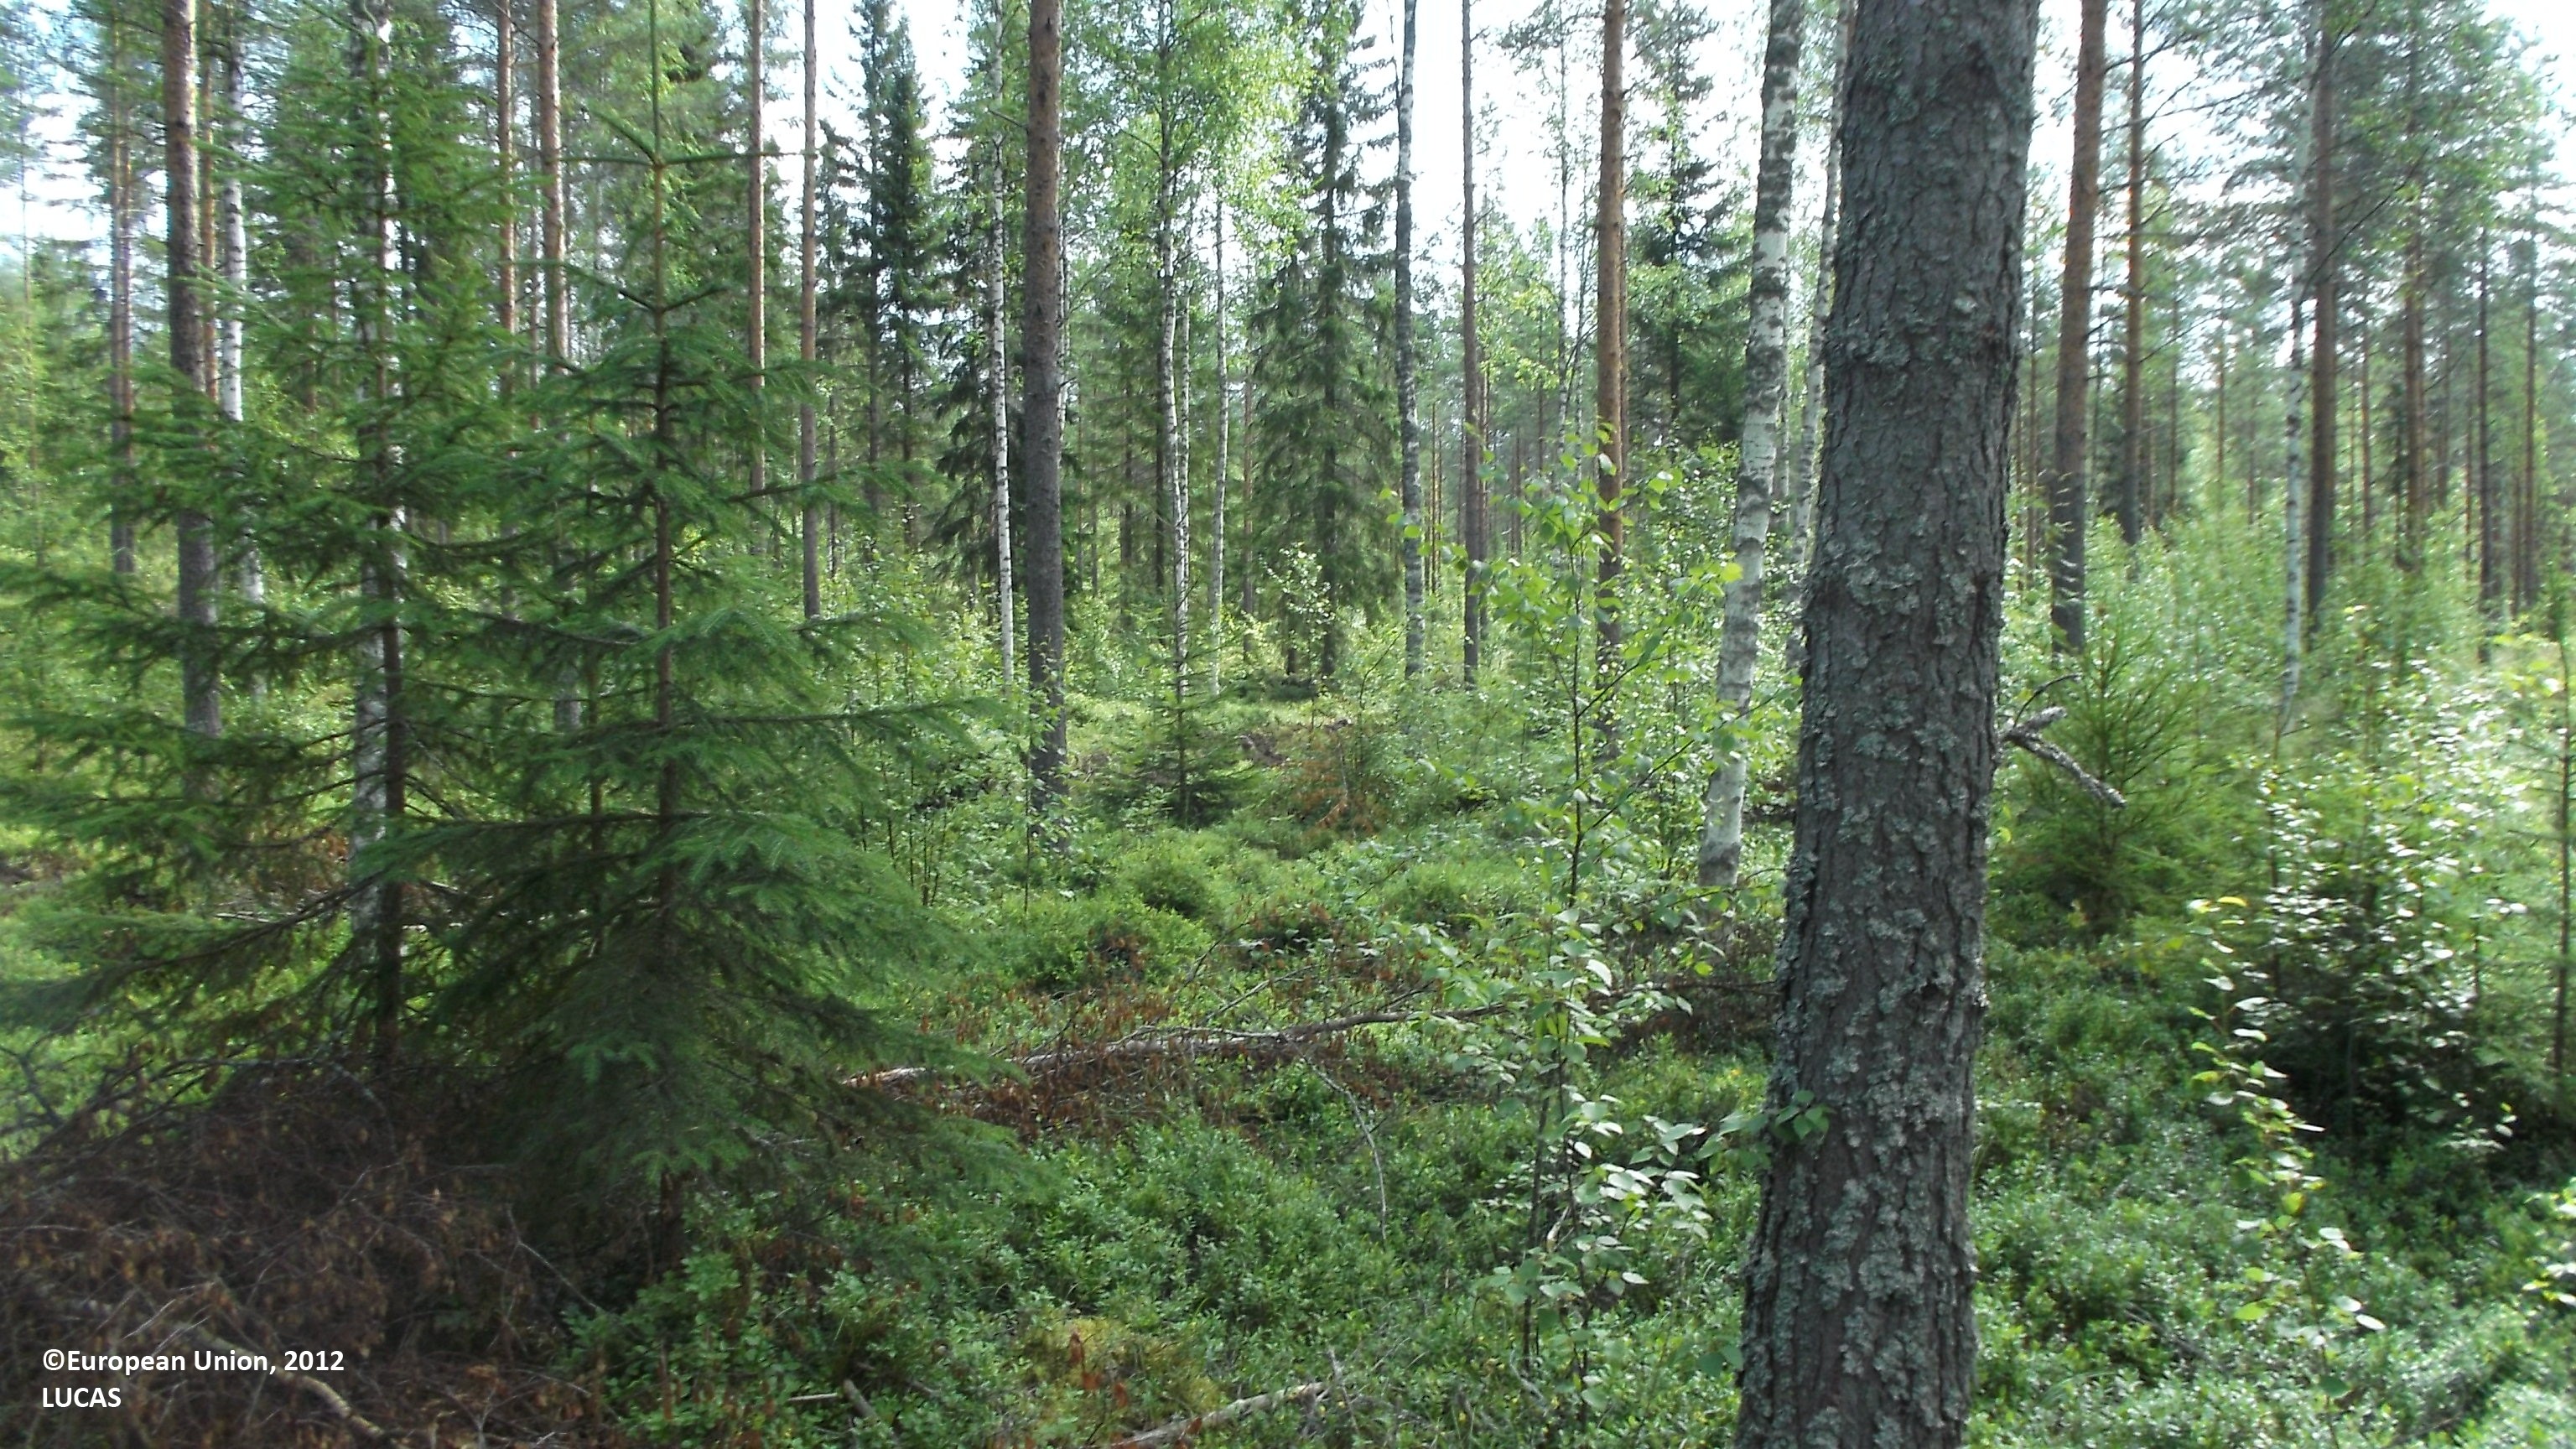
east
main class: Woodland
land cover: Other mixed woodland
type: boreal forest
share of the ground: 25 - 50 %
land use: Forestry
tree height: > 5 m
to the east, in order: Other mixed woodland; Pine dominated mixed woodland; Tracks; Pine dominated mixed woodland; Paved roads, cycling and walking lanes; Grass margins; Abandoned hedges; Spontaneously vegetated surfaces; Tracks; Ditches and canals; Pine dominated mixed woodland; Other mixed woodland
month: July
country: FI
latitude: 63.4880
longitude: 23.6993
